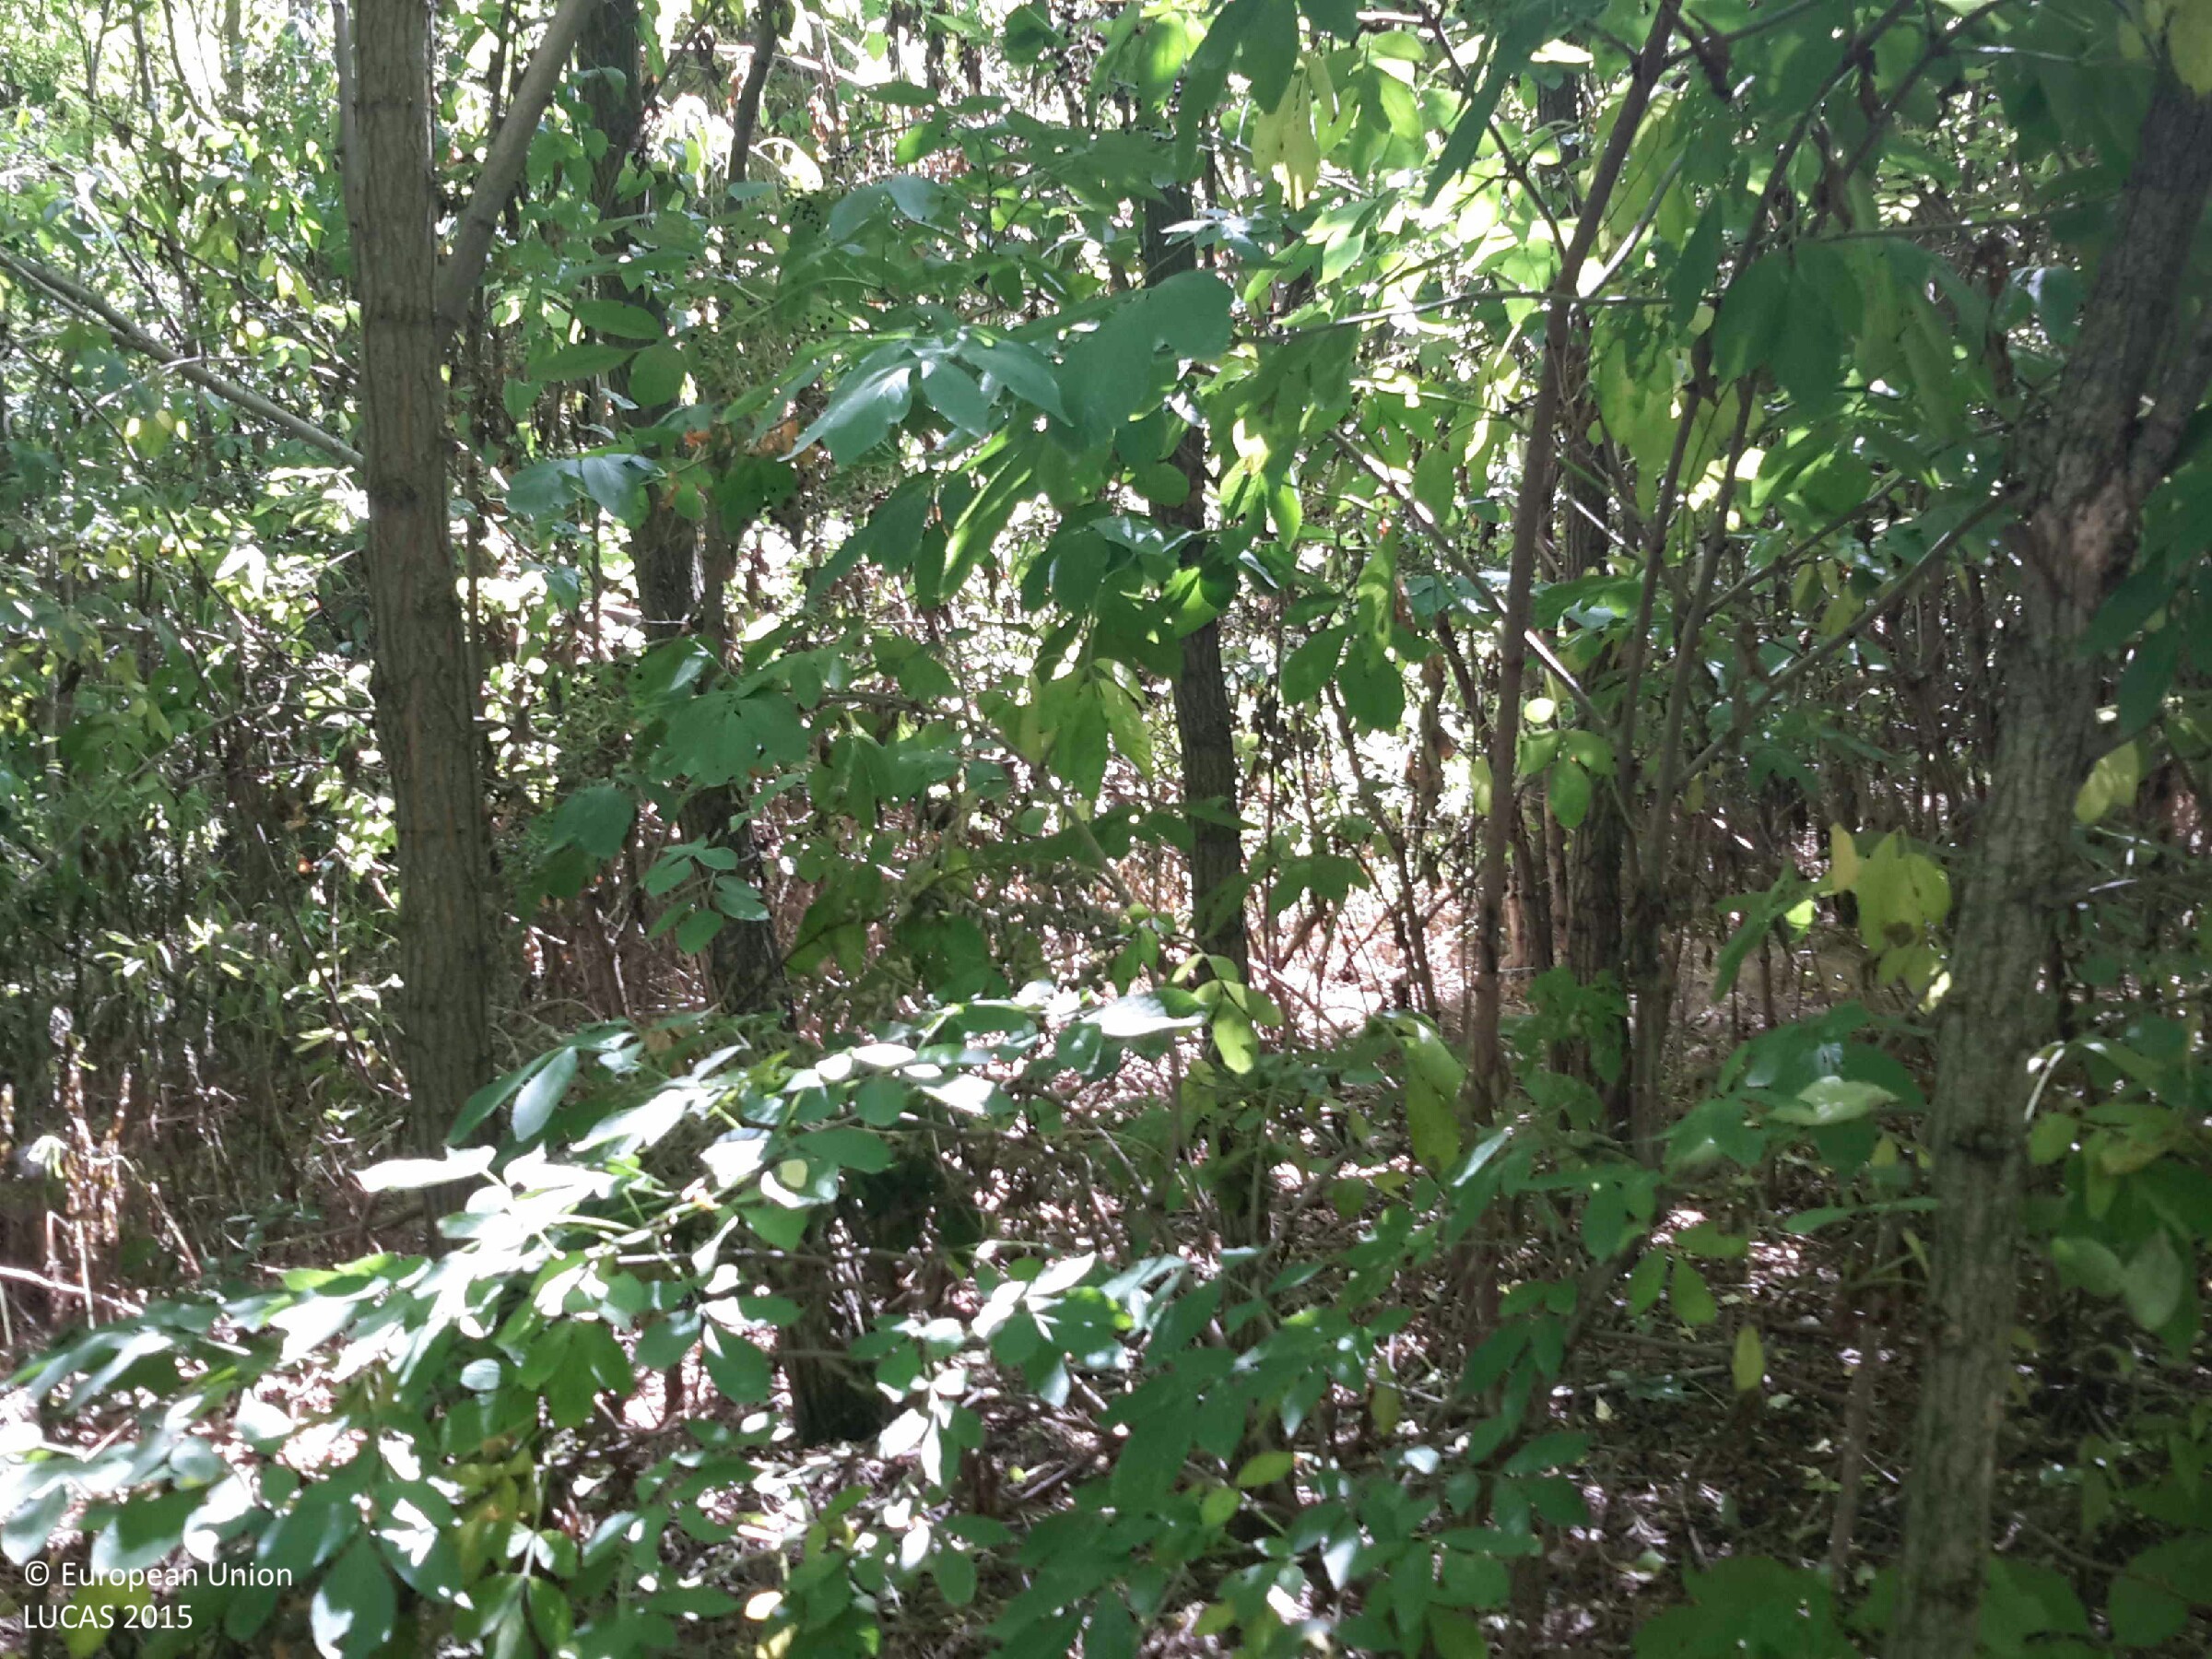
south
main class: Woodland
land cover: Broadleaved woodland
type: exotic forest
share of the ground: > 75 %
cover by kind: broadleaved forest trees 90 %, herbaceous plants 10 %
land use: Forestry
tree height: > 5 m
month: July
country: HU
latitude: 47.7640
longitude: 17.5741
